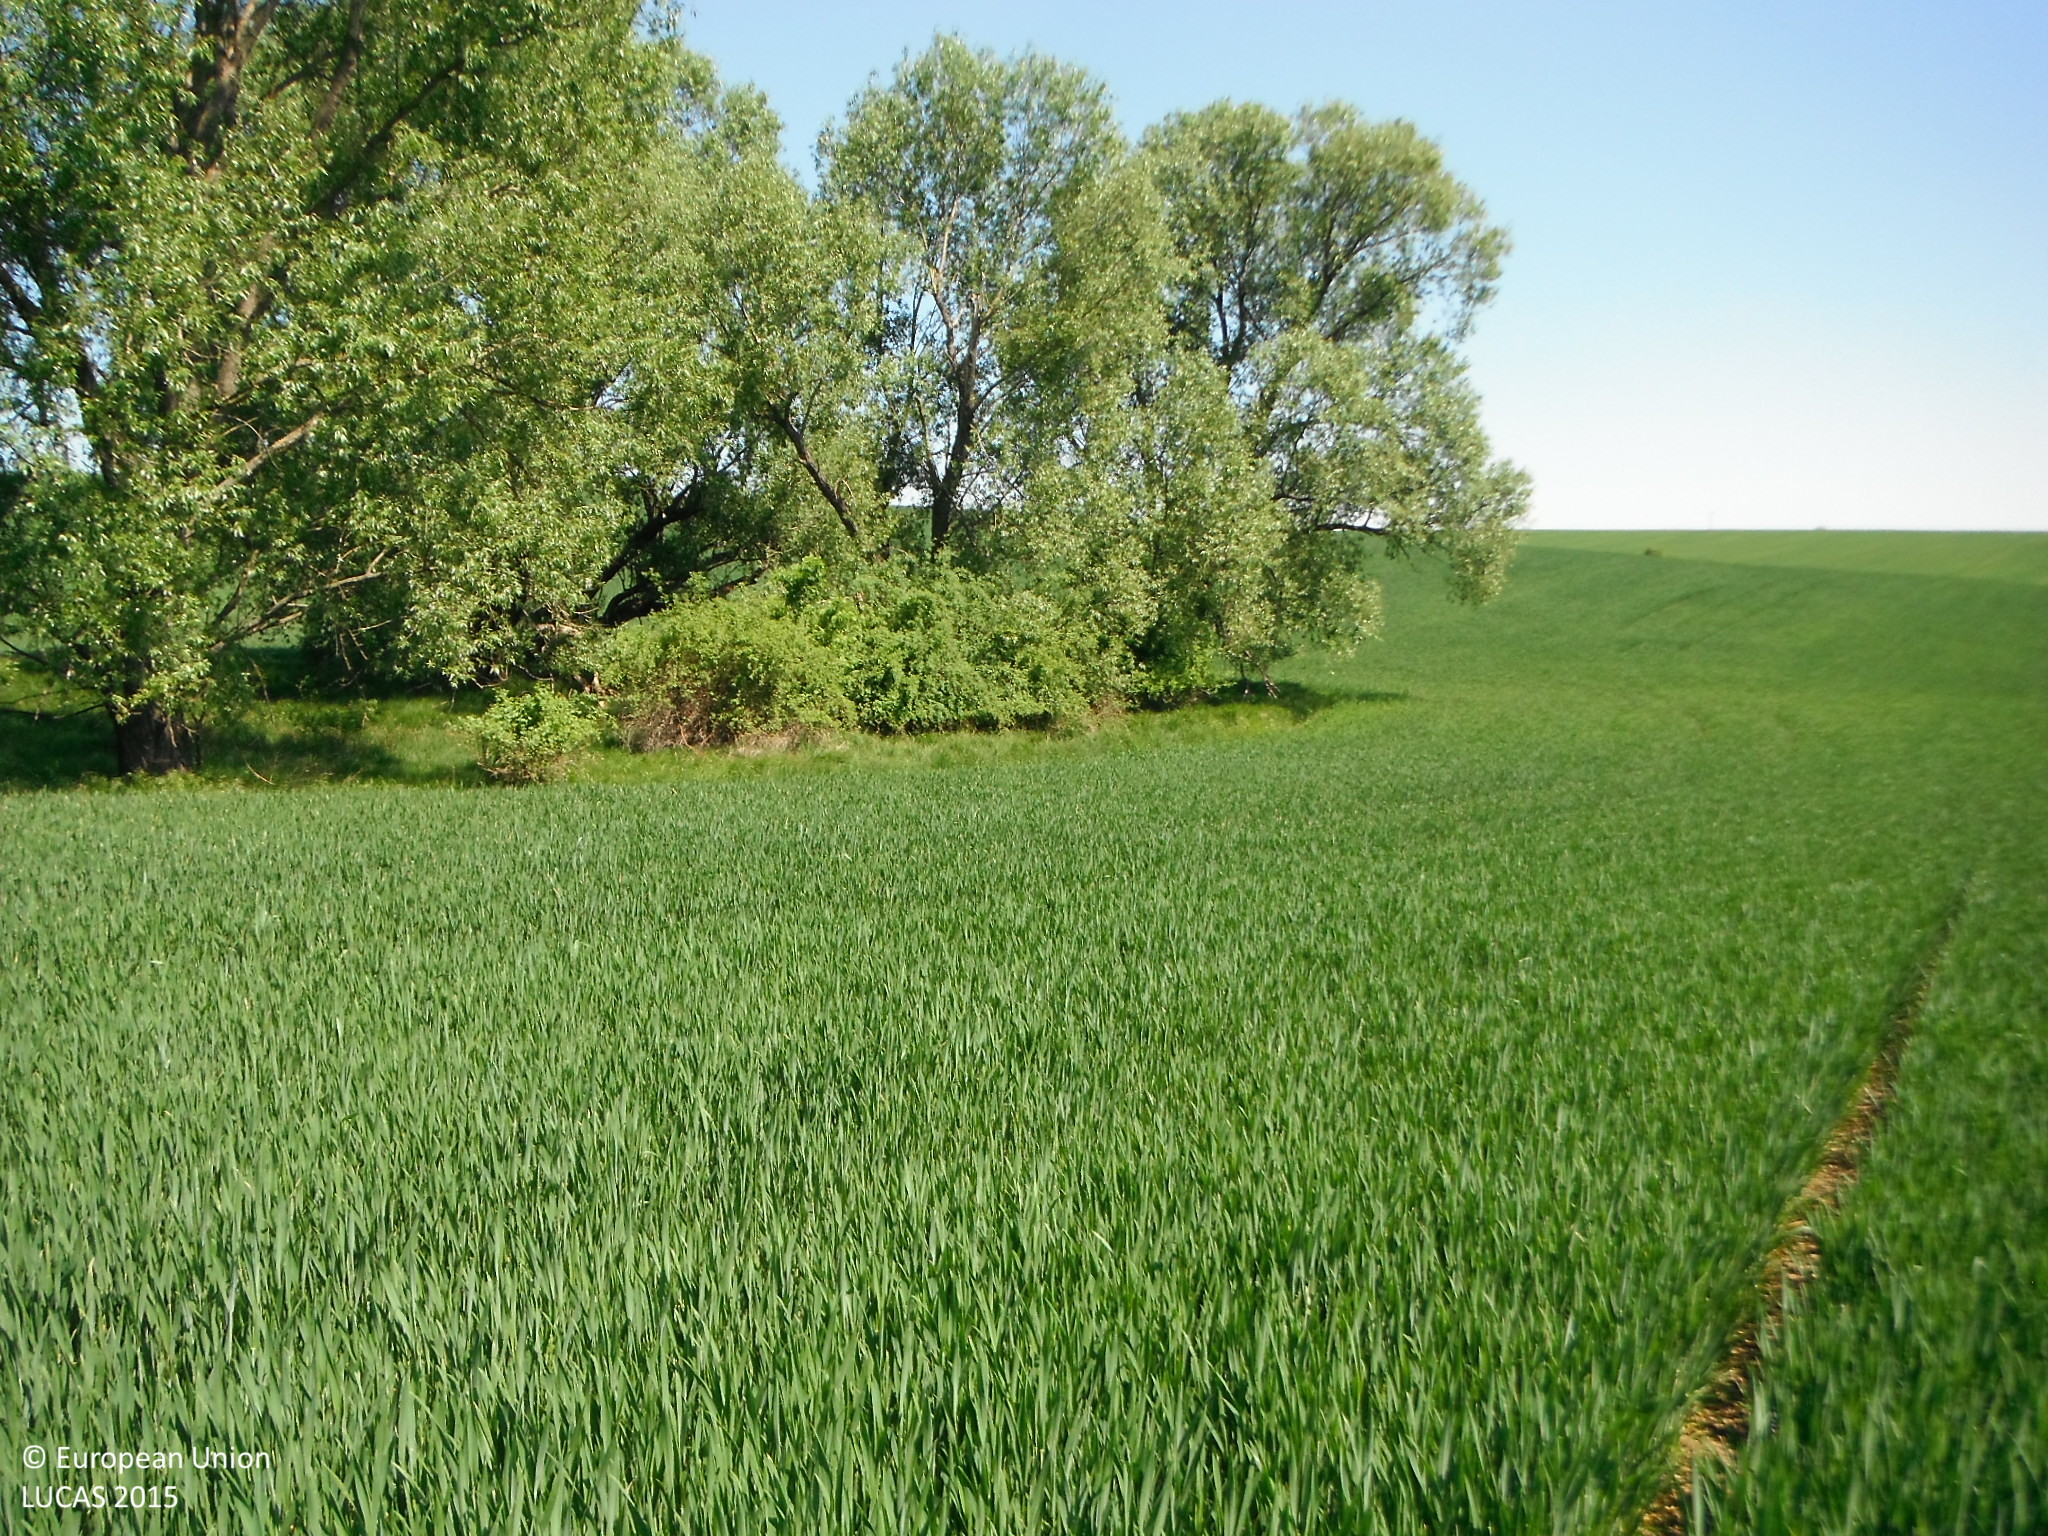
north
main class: Cropland
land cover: Common wheat
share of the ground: > 75 %
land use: Agriculture (excluding fallow land and kitchen gardens)
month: May
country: SK
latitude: 48.3136
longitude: 18.2265
